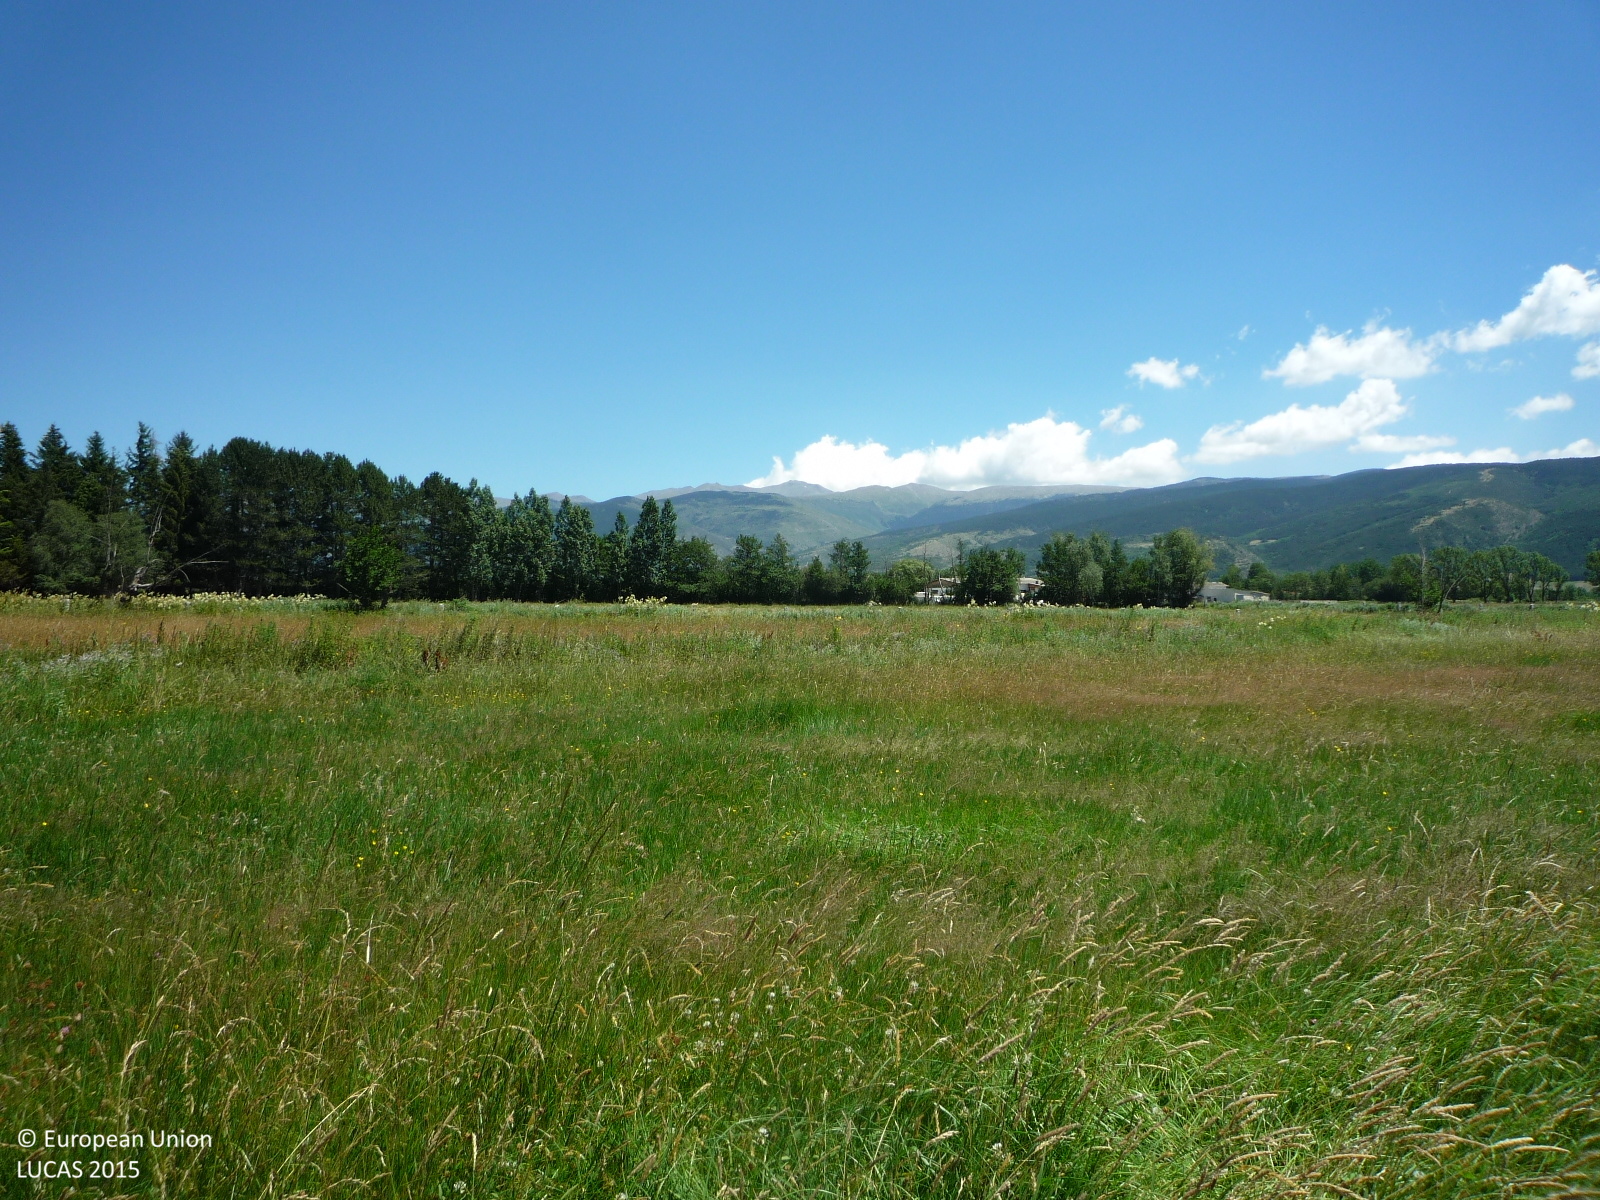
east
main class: Grassland
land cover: Grassland without tree/shrub cover
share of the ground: > 75 %
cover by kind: herbaceous plants 100 %
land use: Semi-natural and natural areas not in use
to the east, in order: Grassland without tree/shrub cover; Grass margins; Ditches and canals; Grass margins; Grassland without tree/shrub cover; Fences; Grass margins; Fences; Grassland without tree/shrub cover; Fences; Managed hedges; Temporary grasslands
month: July
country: ES
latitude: 42.4203
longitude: 1.9050
